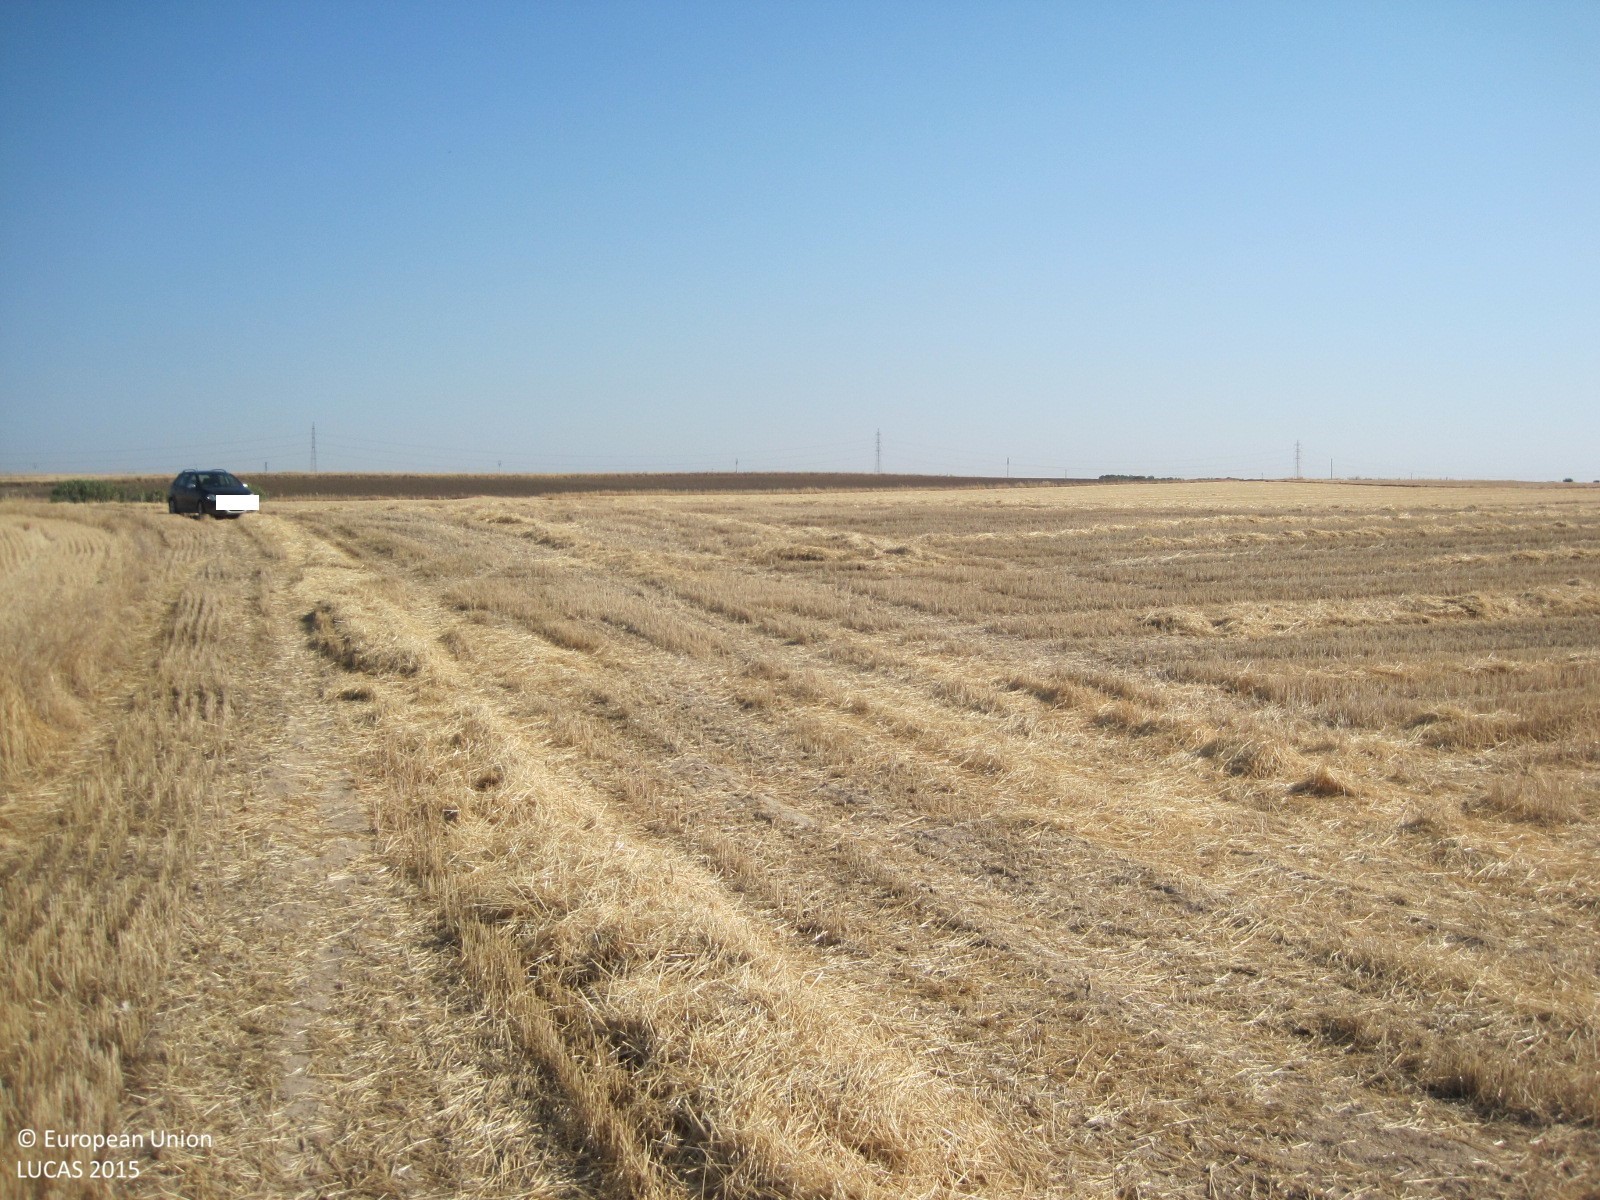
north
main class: Cropland
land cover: Common wheat
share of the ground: < 10 %
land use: Agriculture (excluding fallow land and kitchen gardens)
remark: Harvested field
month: July
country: ES
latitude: 40.1587
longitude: -3.8547
